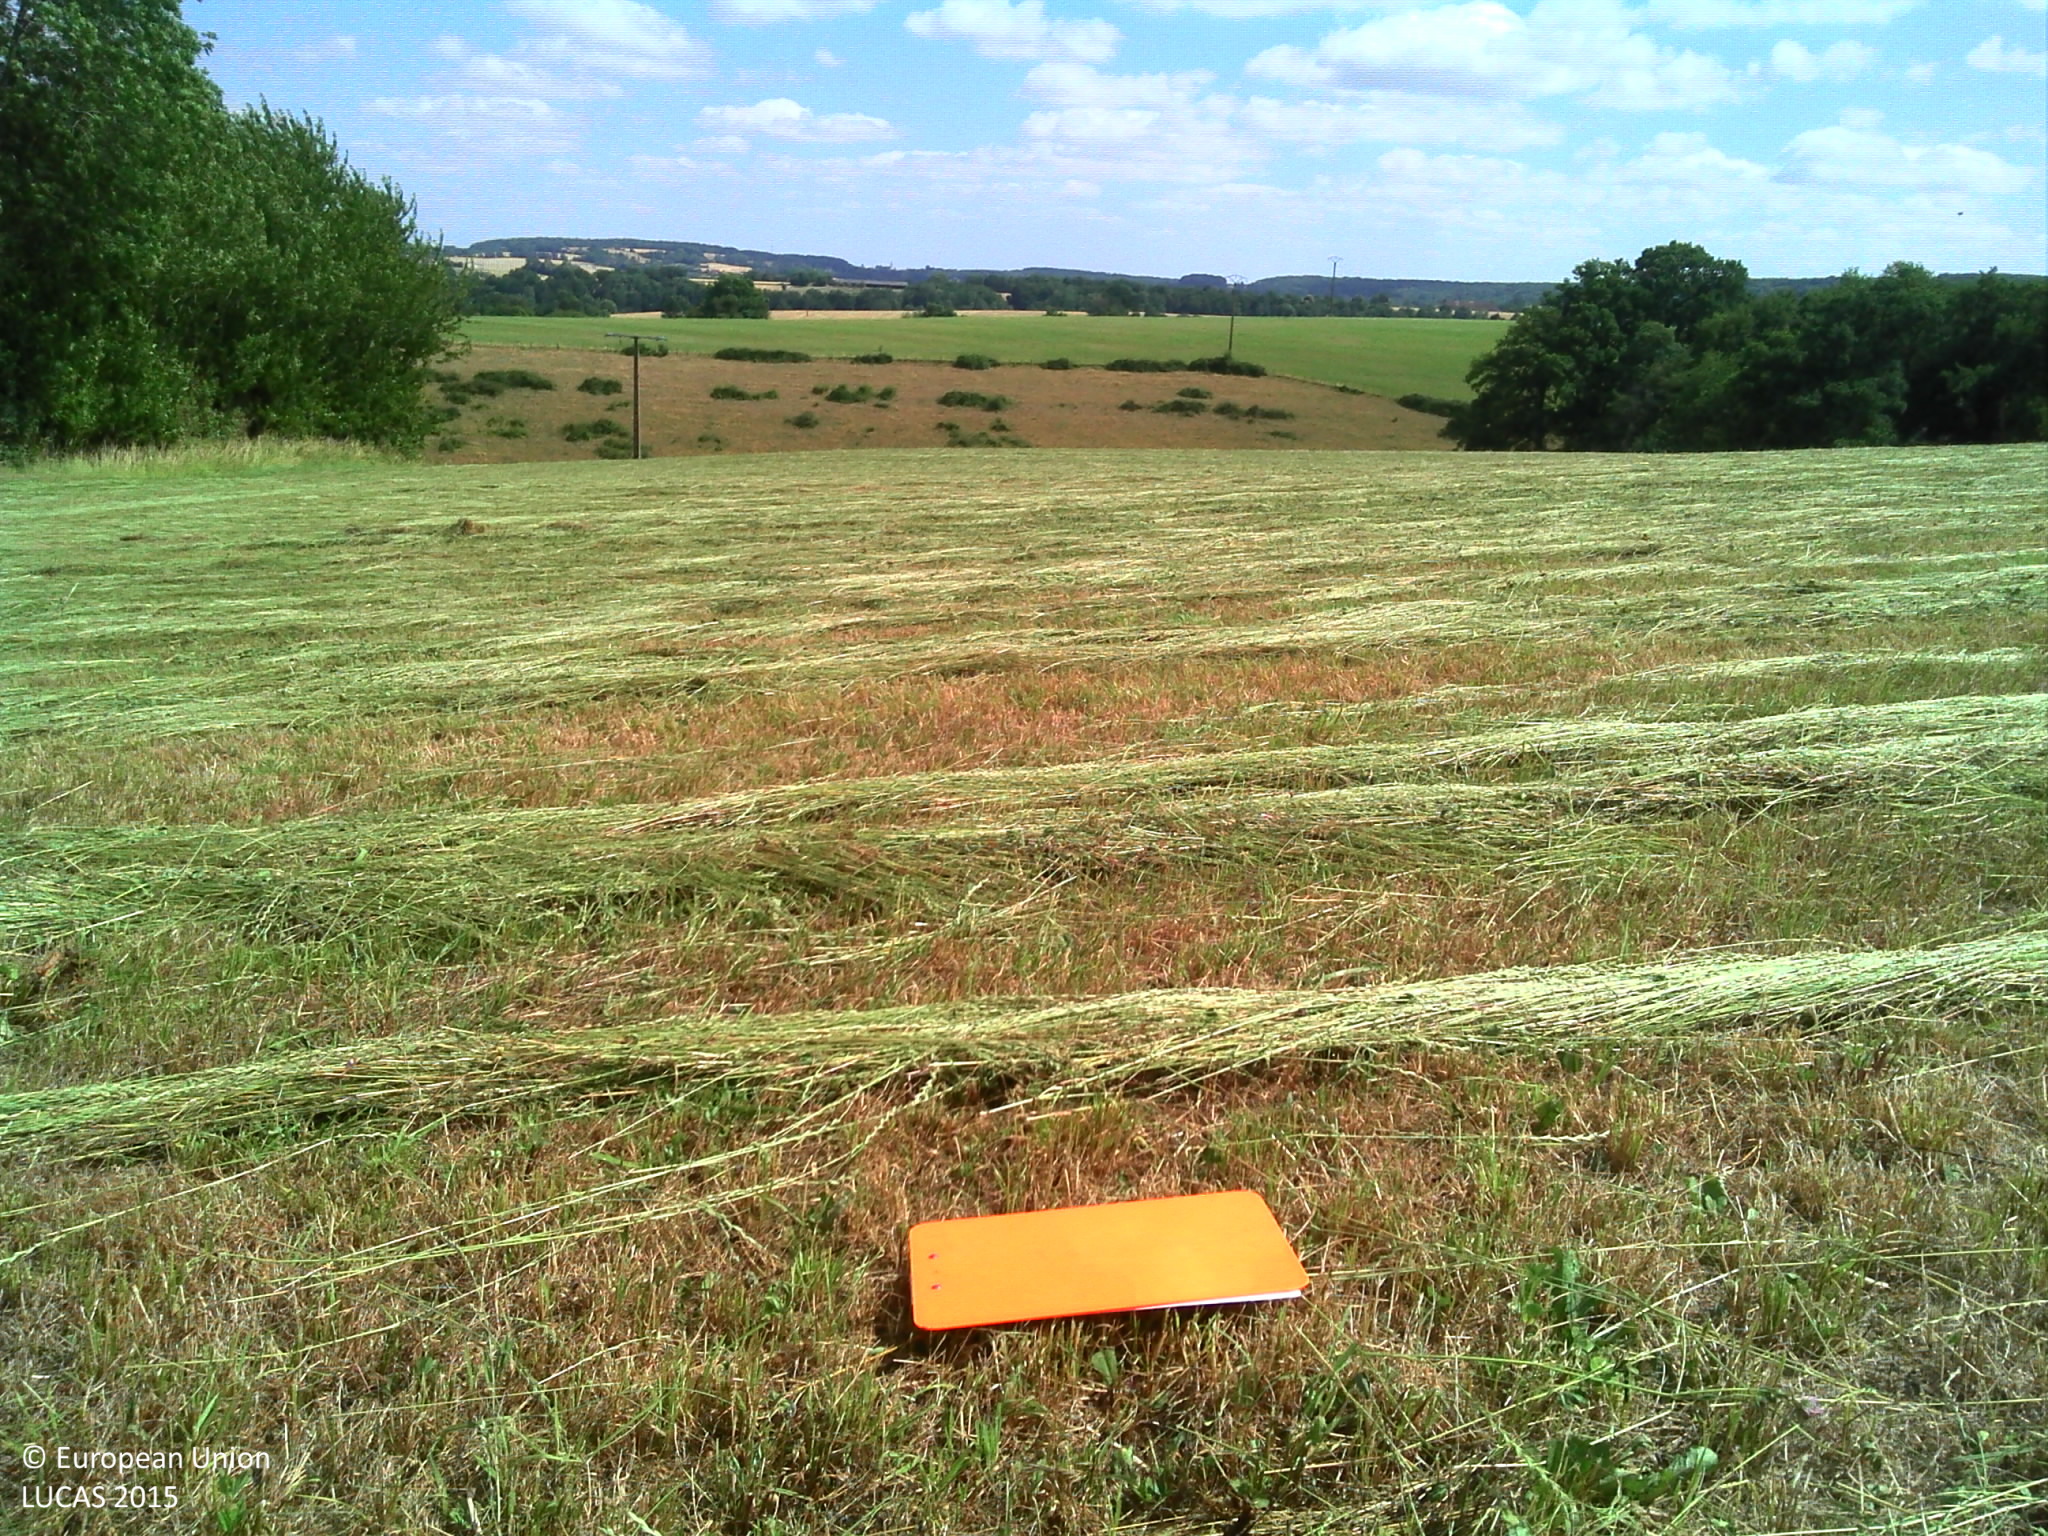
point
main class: Grassland
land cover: Grassland without tree/shrub cover
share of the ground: > 75 %
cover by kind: herbaceous plants 100 %
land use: Agriculture (excluding fallow land and kitchen gardens)
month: July
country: FR
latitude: 48.2396
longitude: 0.8361
